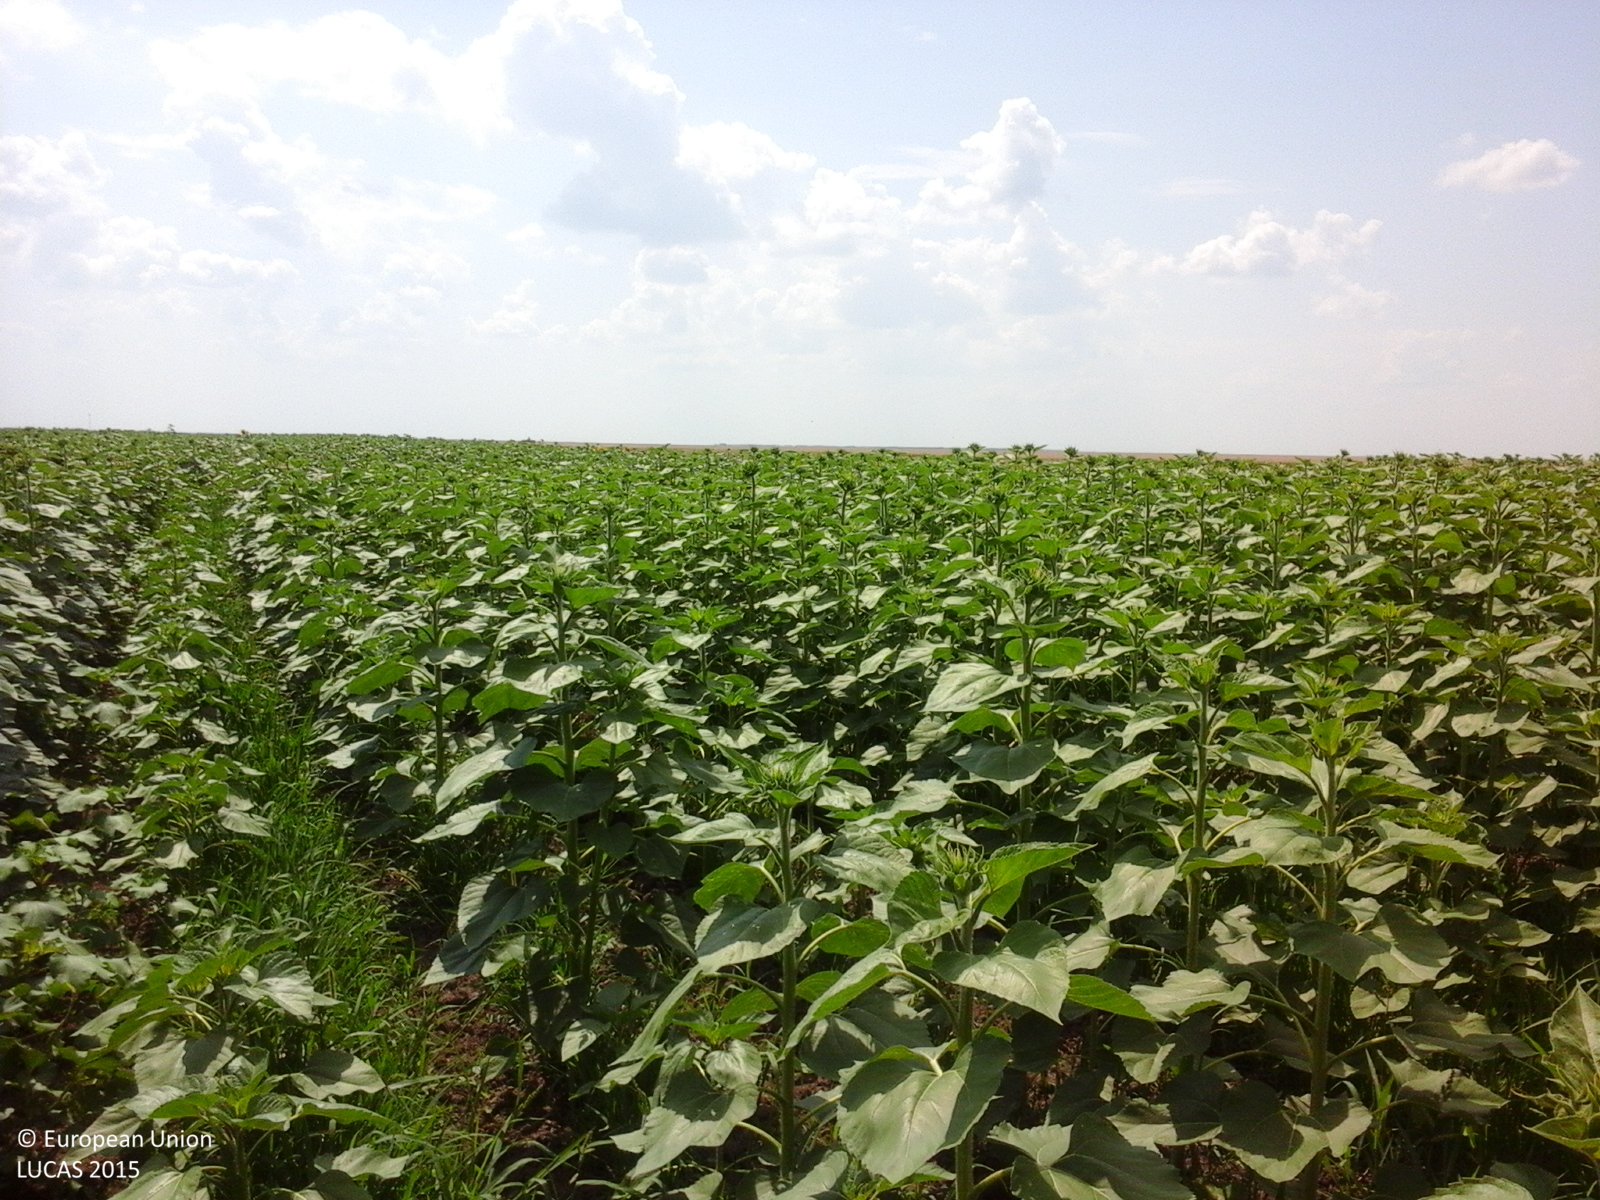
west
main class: Cropland
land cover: Sunflower
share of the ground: > 75 %
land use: Agriculture (excluding fallow land and kitchen gardens)
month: July
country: RO
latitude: 44.0551
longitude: 25.2736
